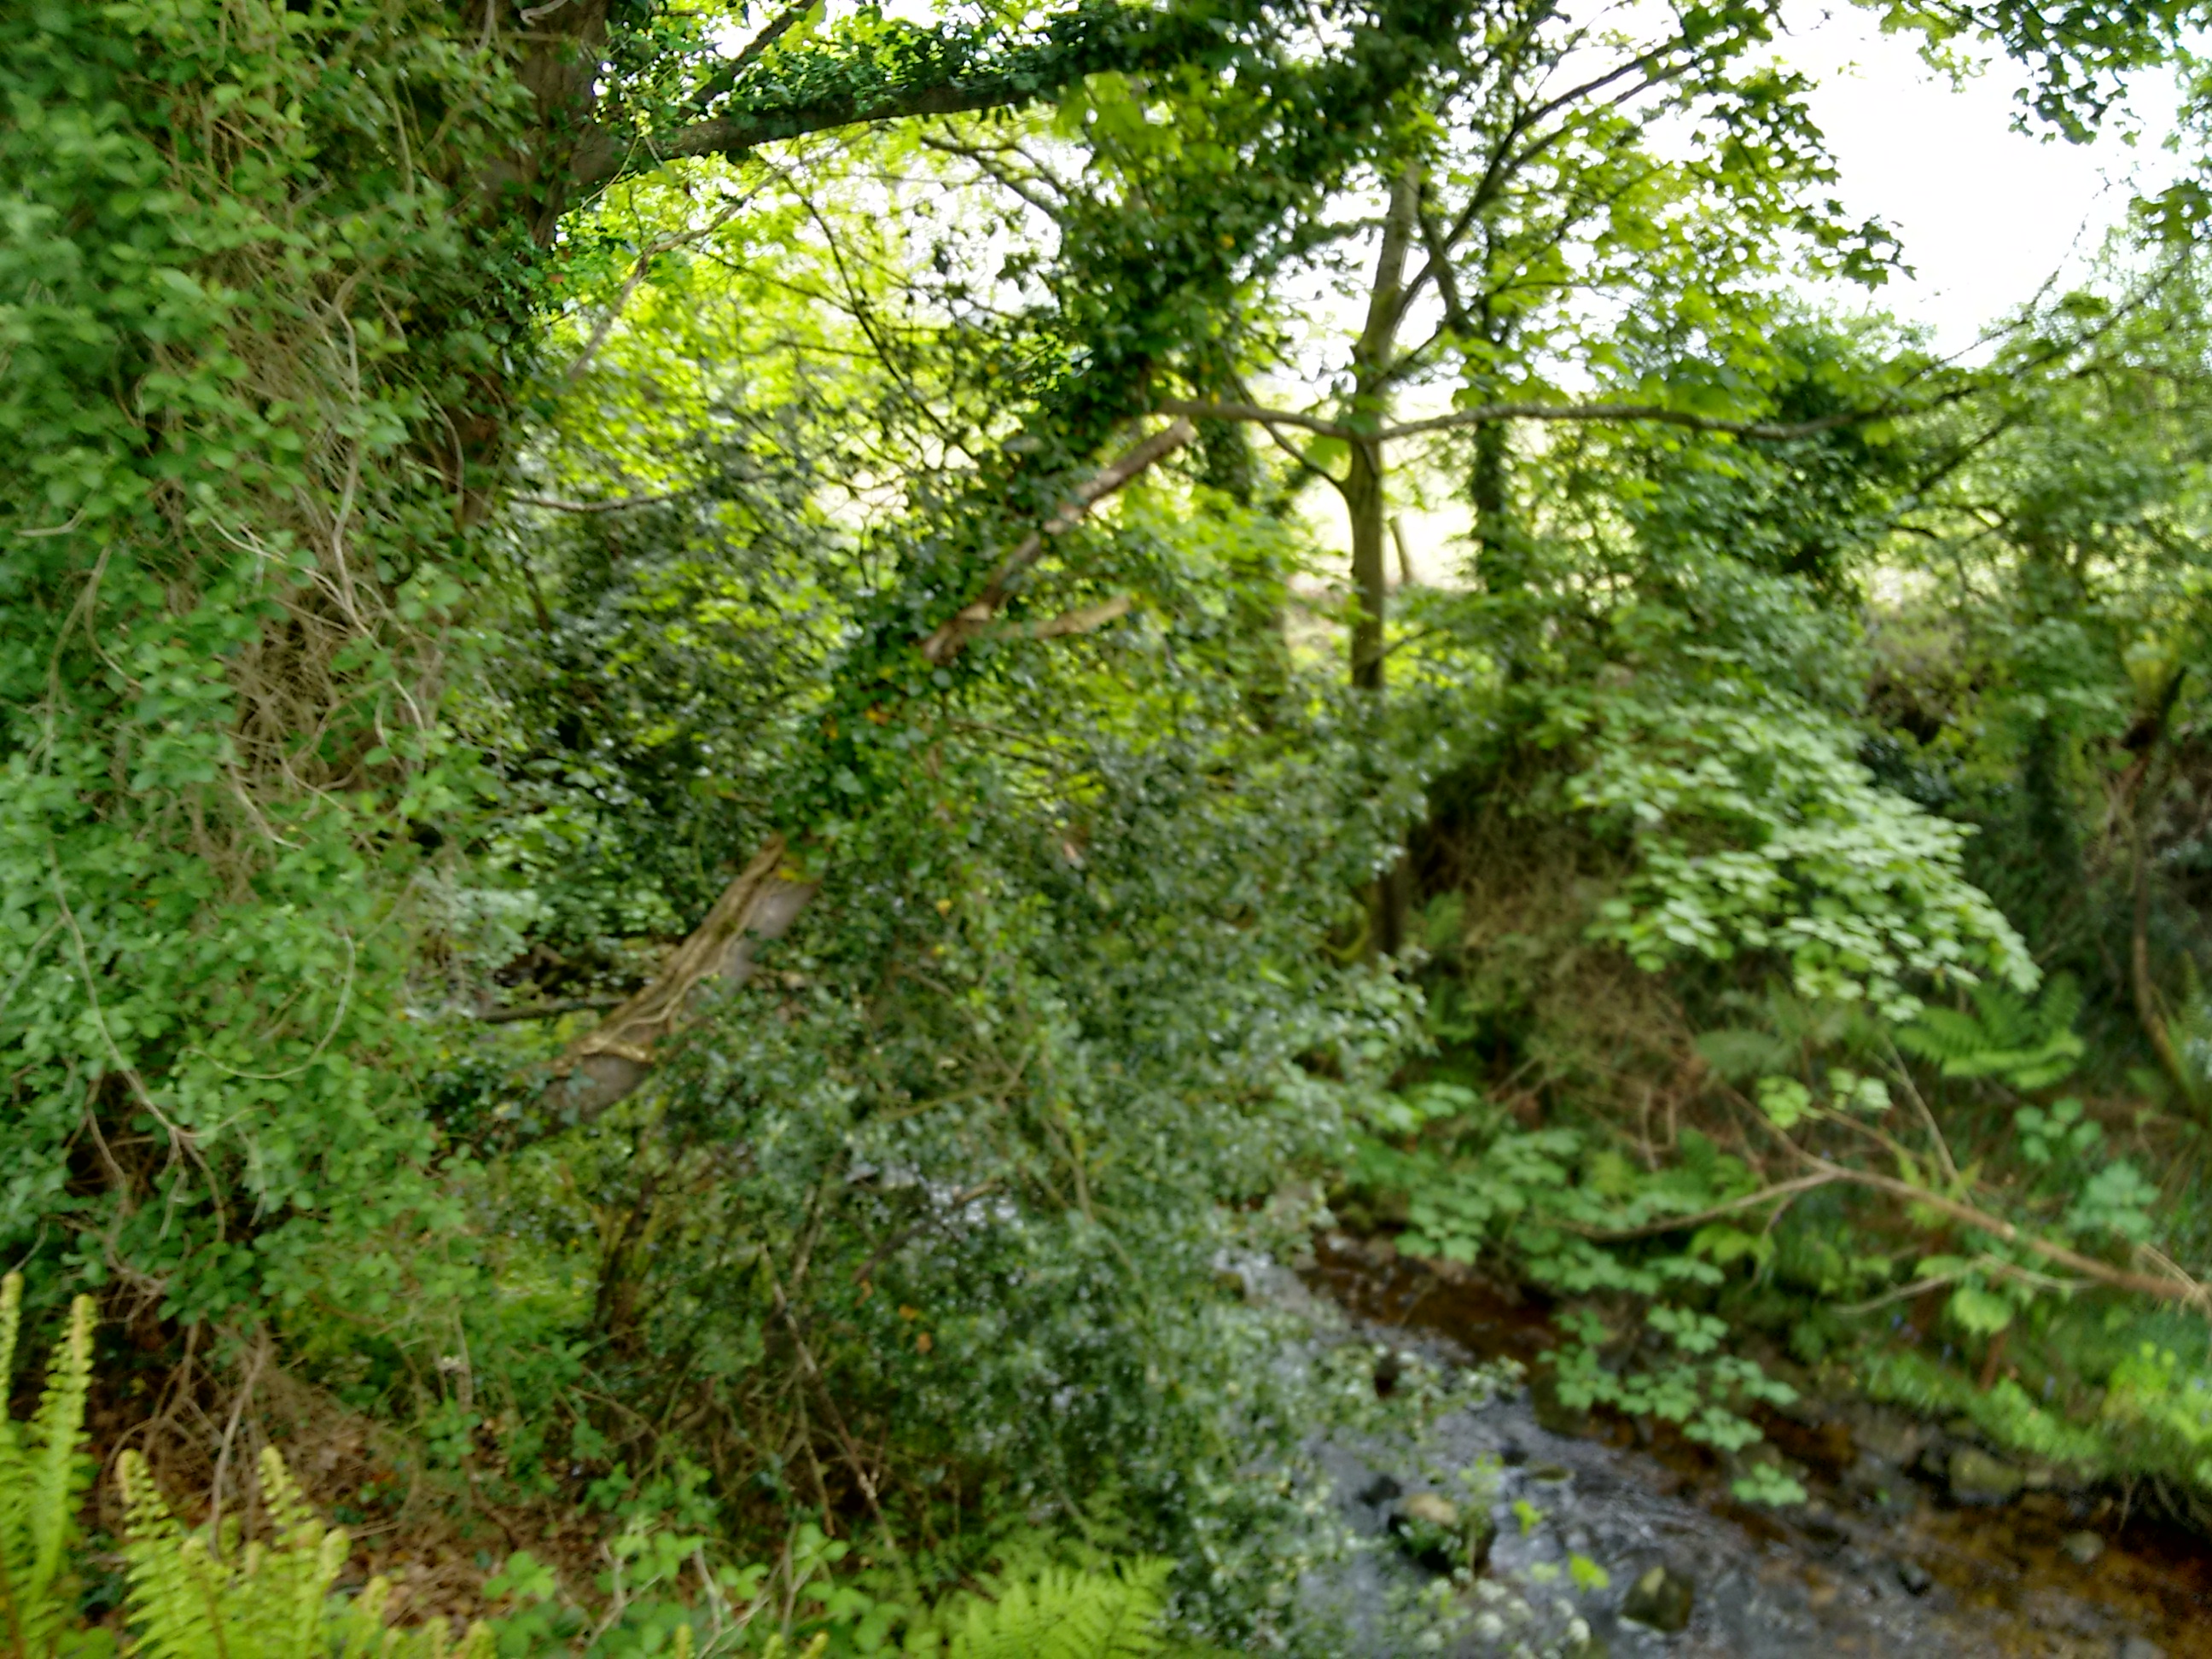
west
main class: Woodland
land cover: Broadleaved woodland
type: floodplain forest
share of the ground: > 75 %
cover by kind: broadleaved forest trees 100 %
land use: Semi-natural and natural areas not in use
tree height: > 5 m
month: May
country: GB
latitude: 55.0374
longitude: -7.0221
